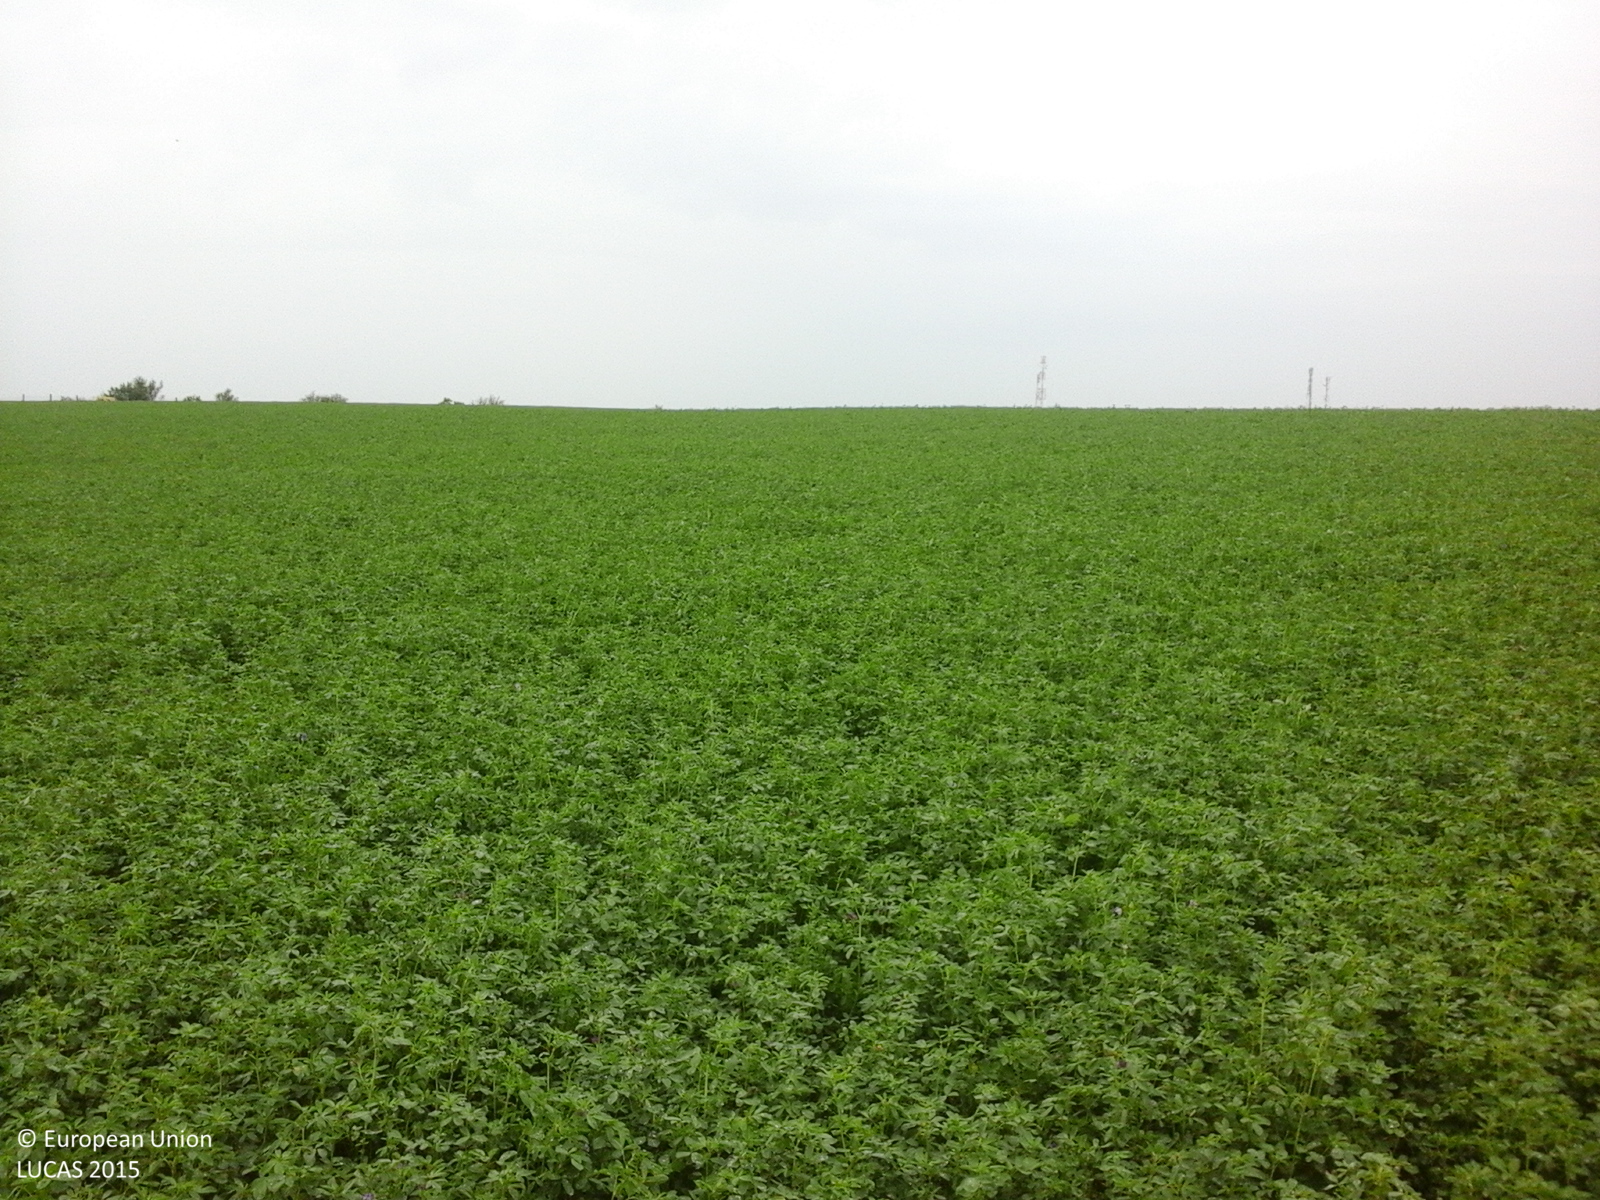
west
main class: Cropland
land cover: Lucerne
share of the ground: > 75 %
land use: Agriculture (excluding fallow land and kitchen gardens)
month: September
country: RO
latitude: 47.3409
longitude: 22.3764
